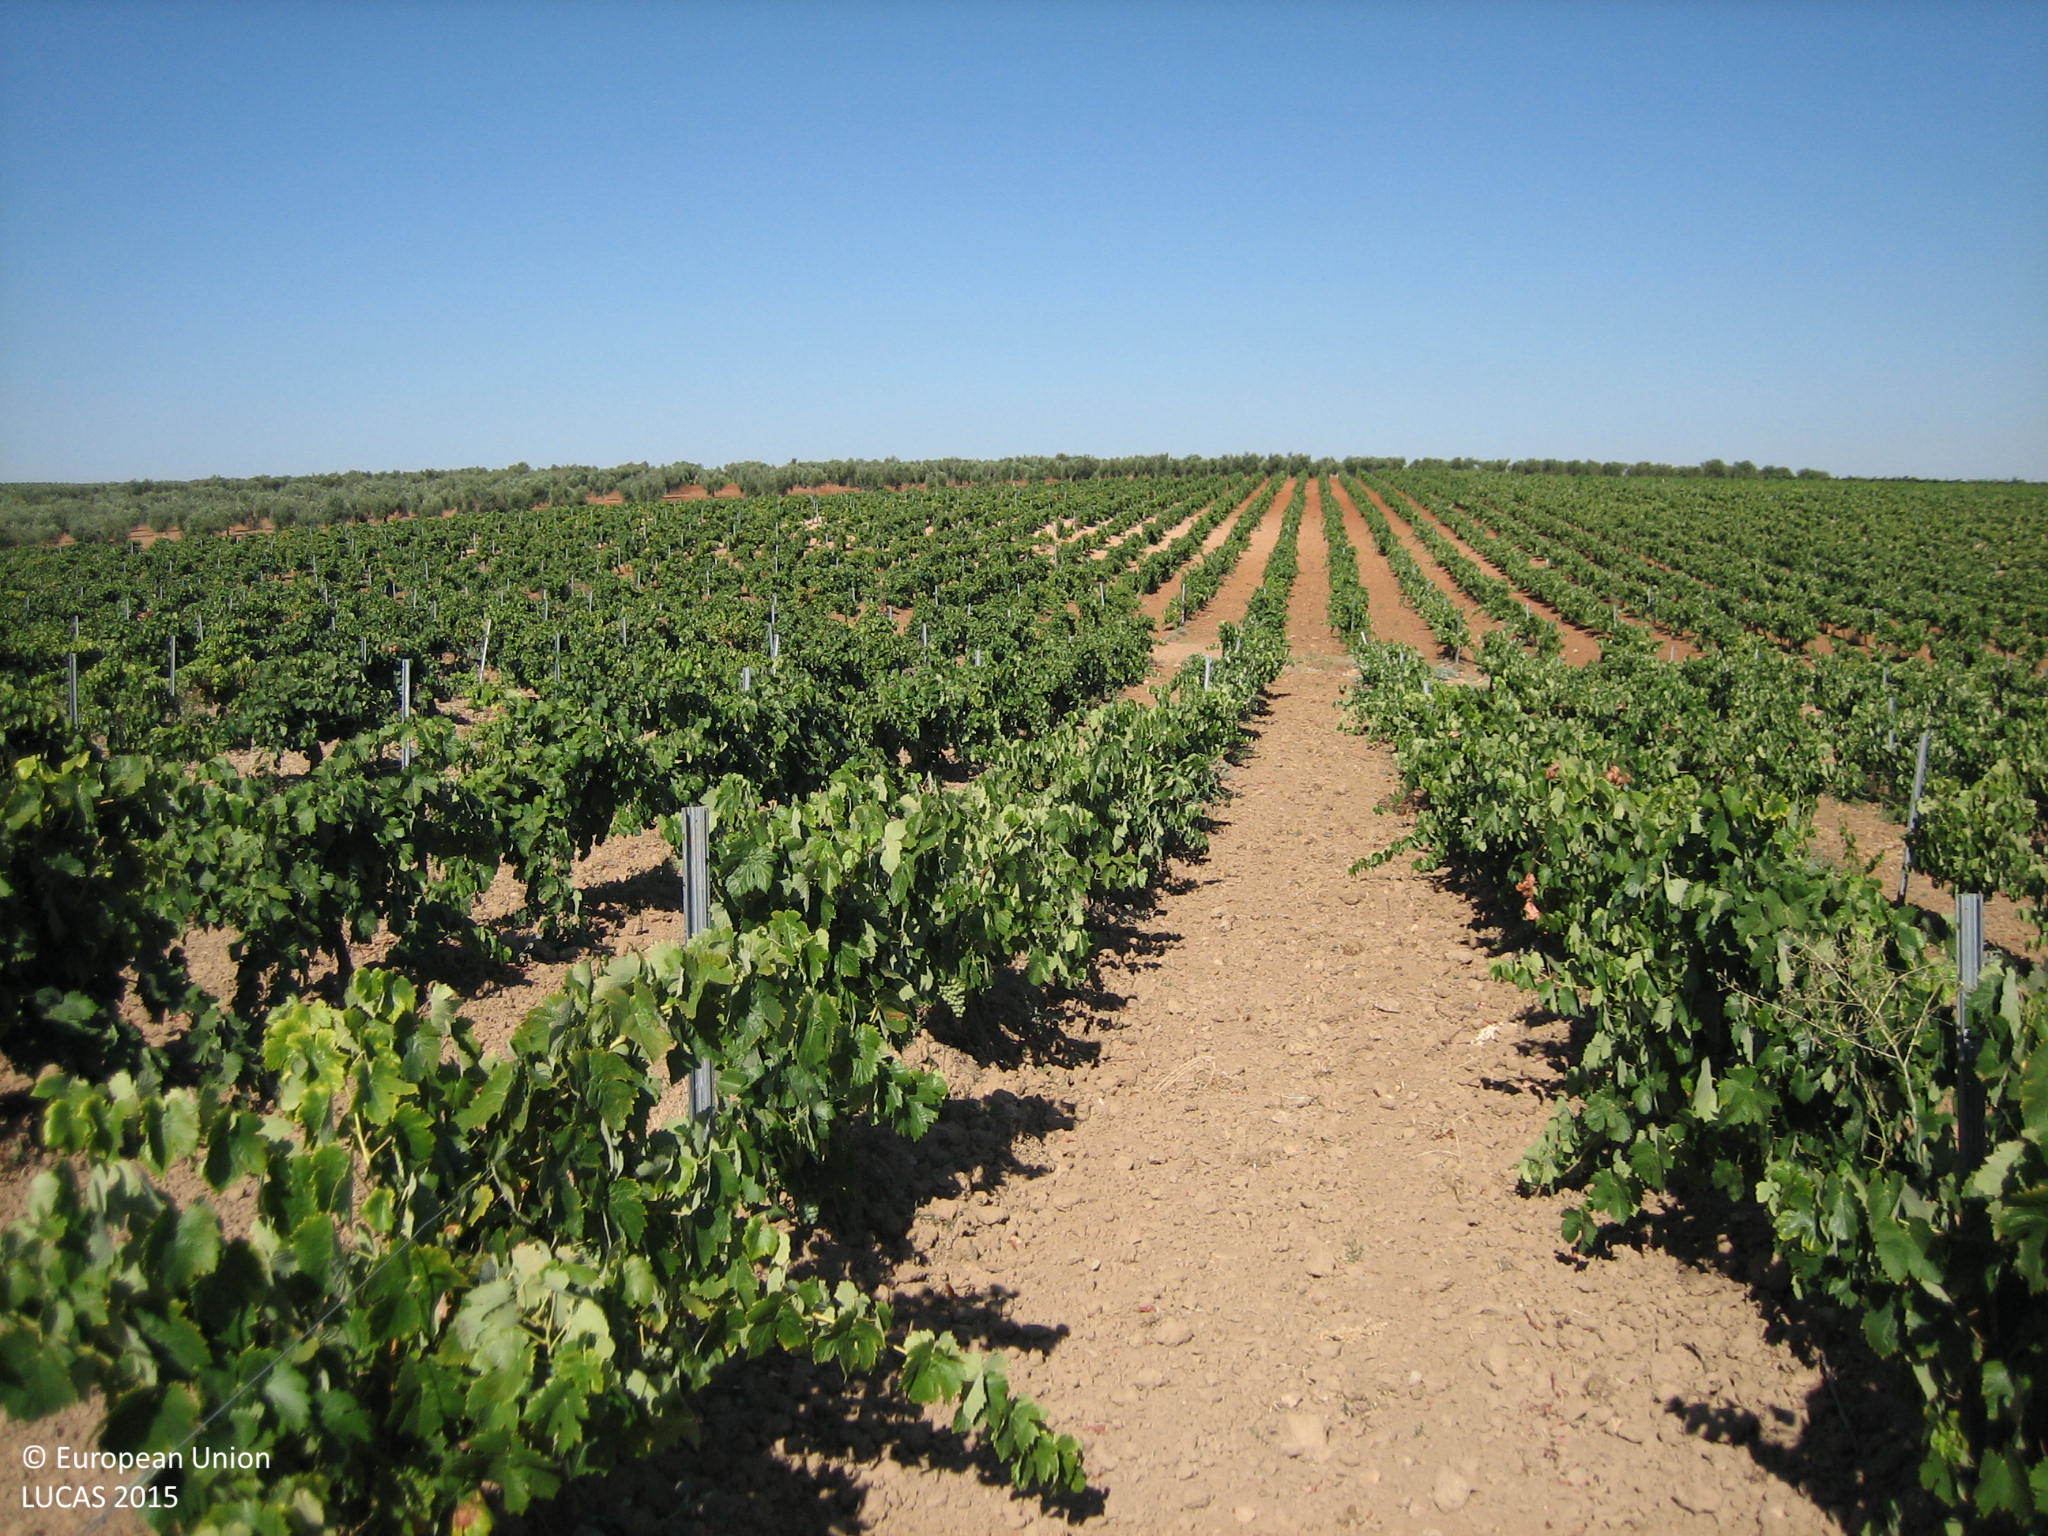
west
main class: Cropland
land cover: Vineyards
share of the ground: 25 - 50 %
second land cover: Other bare soil
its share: > 75 %
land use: Agriculture (excluding fallow land and kitchen gardens)
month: July
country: ES
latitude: 38.4817
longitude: -6.3395
